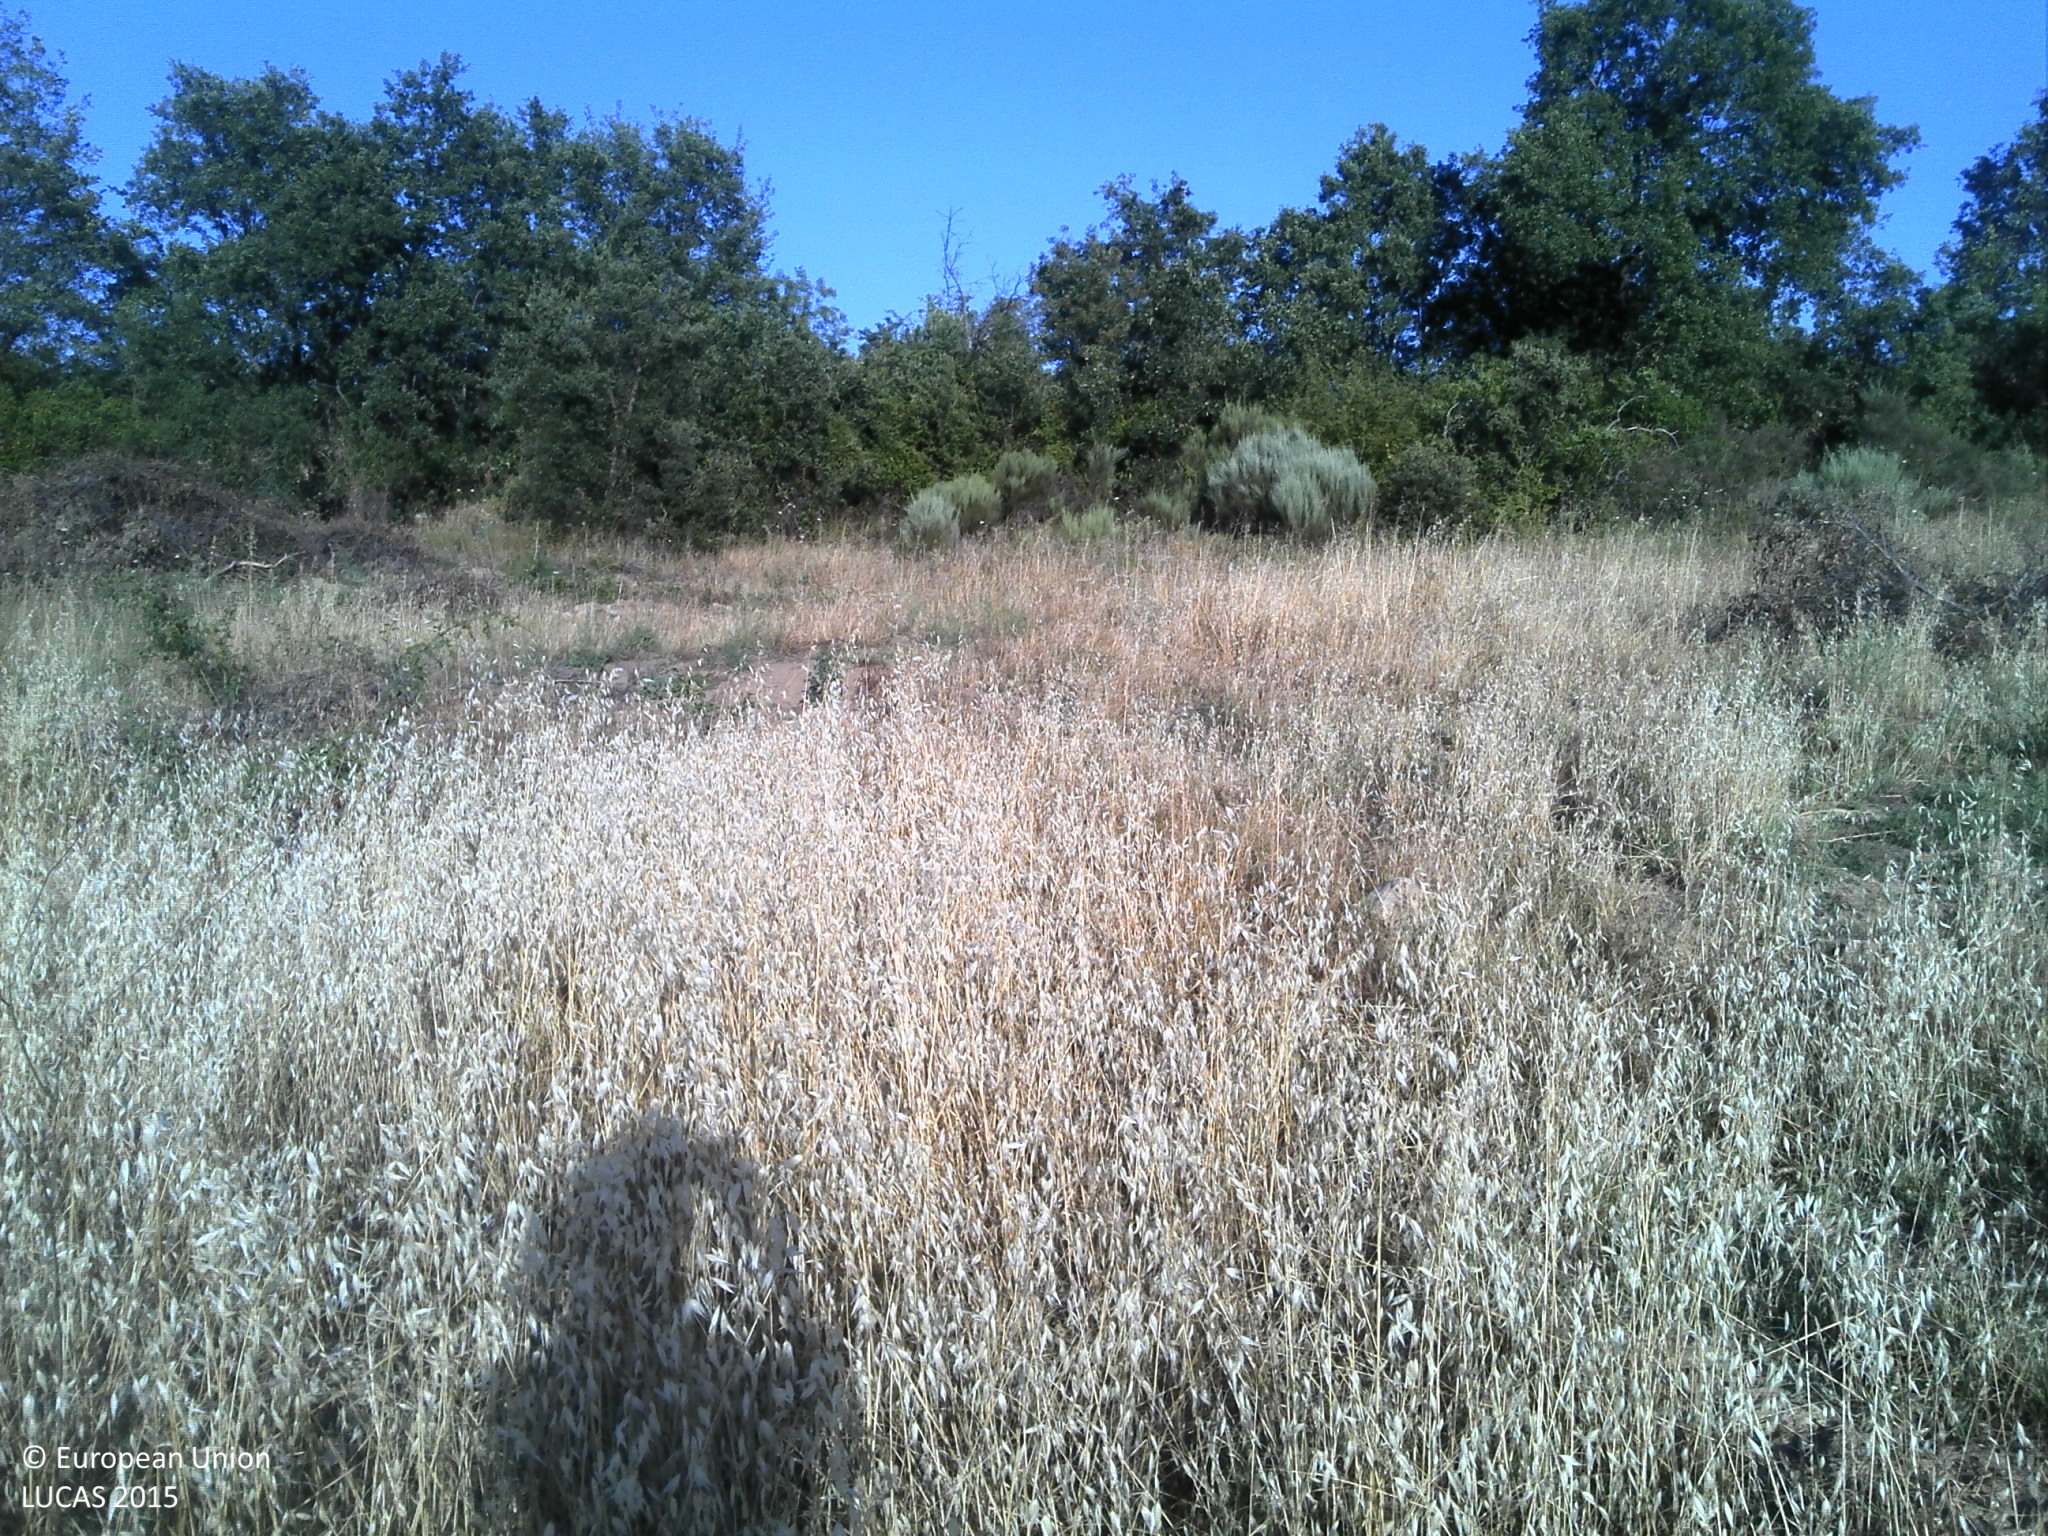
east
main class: Grassland
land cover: Grassland with sparse tree/shrub cover
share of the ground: 50 - 75 %
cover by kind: herbaceous plants 70 %, unconsolidated bare surface 20 %, broadleaved forest trees 5 %
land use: Agriculture (excluding fallow land and kitchen gardens)
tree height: > 5 m
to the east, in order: Grassland with sparse tree/shrub cover; Abandoned hedges; Dry stone walls; Grassland with sparse tree/shrub cover; Tracks; Grassland with sparse tree/shrub cover; Abandoned hedges; Grassland without tree/shrub cover
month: June
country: PT
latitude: 39.9684
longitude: -7.3197
